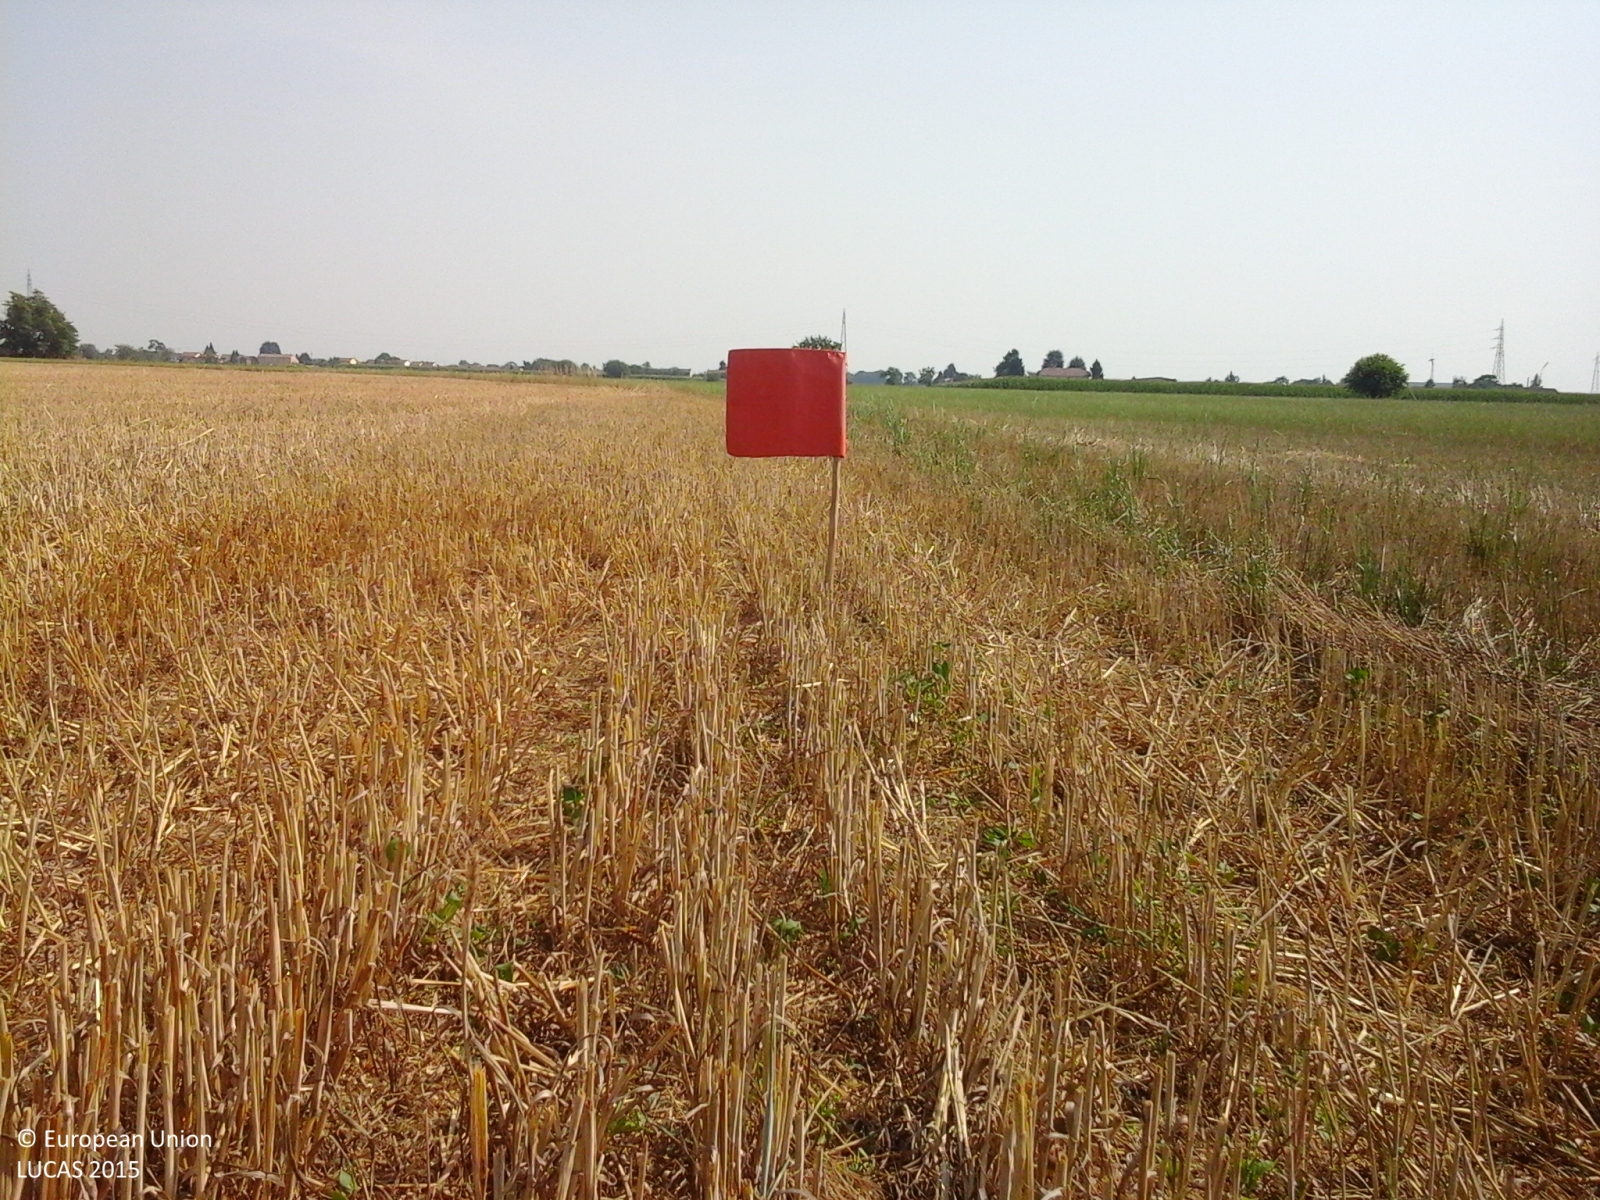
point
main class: Cropland
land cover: Common wheat
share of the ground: 10 - 25 %
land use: Agriculture (excluding fallow land and kitchen gardens)
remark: Harvested field
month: July
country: IT
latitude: 44.9018
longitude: 8.7234
